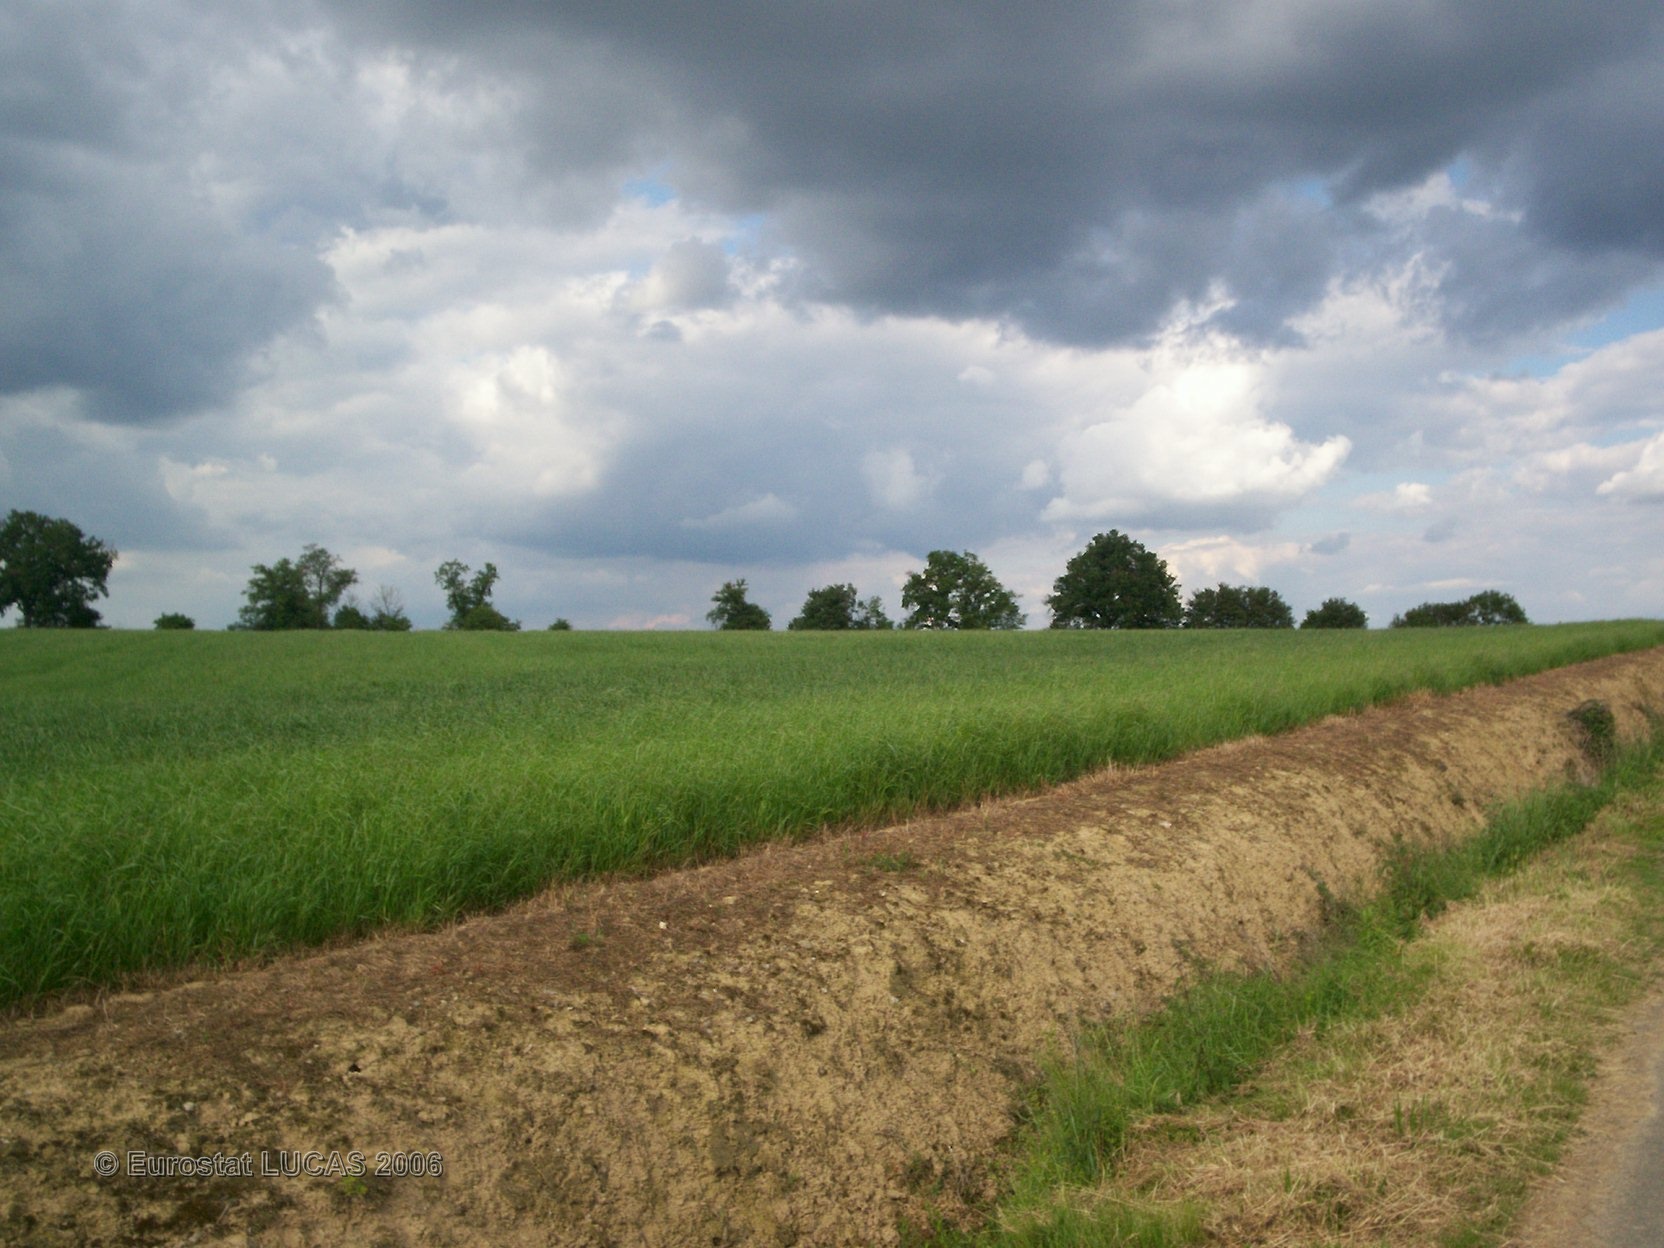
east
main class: Grassland
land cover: Grassland without tree/shrub cover
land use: Agriculture (excluding fallow land and kitchen gardens)
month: May
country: FR
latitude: 47.7769
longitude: -0.4814
